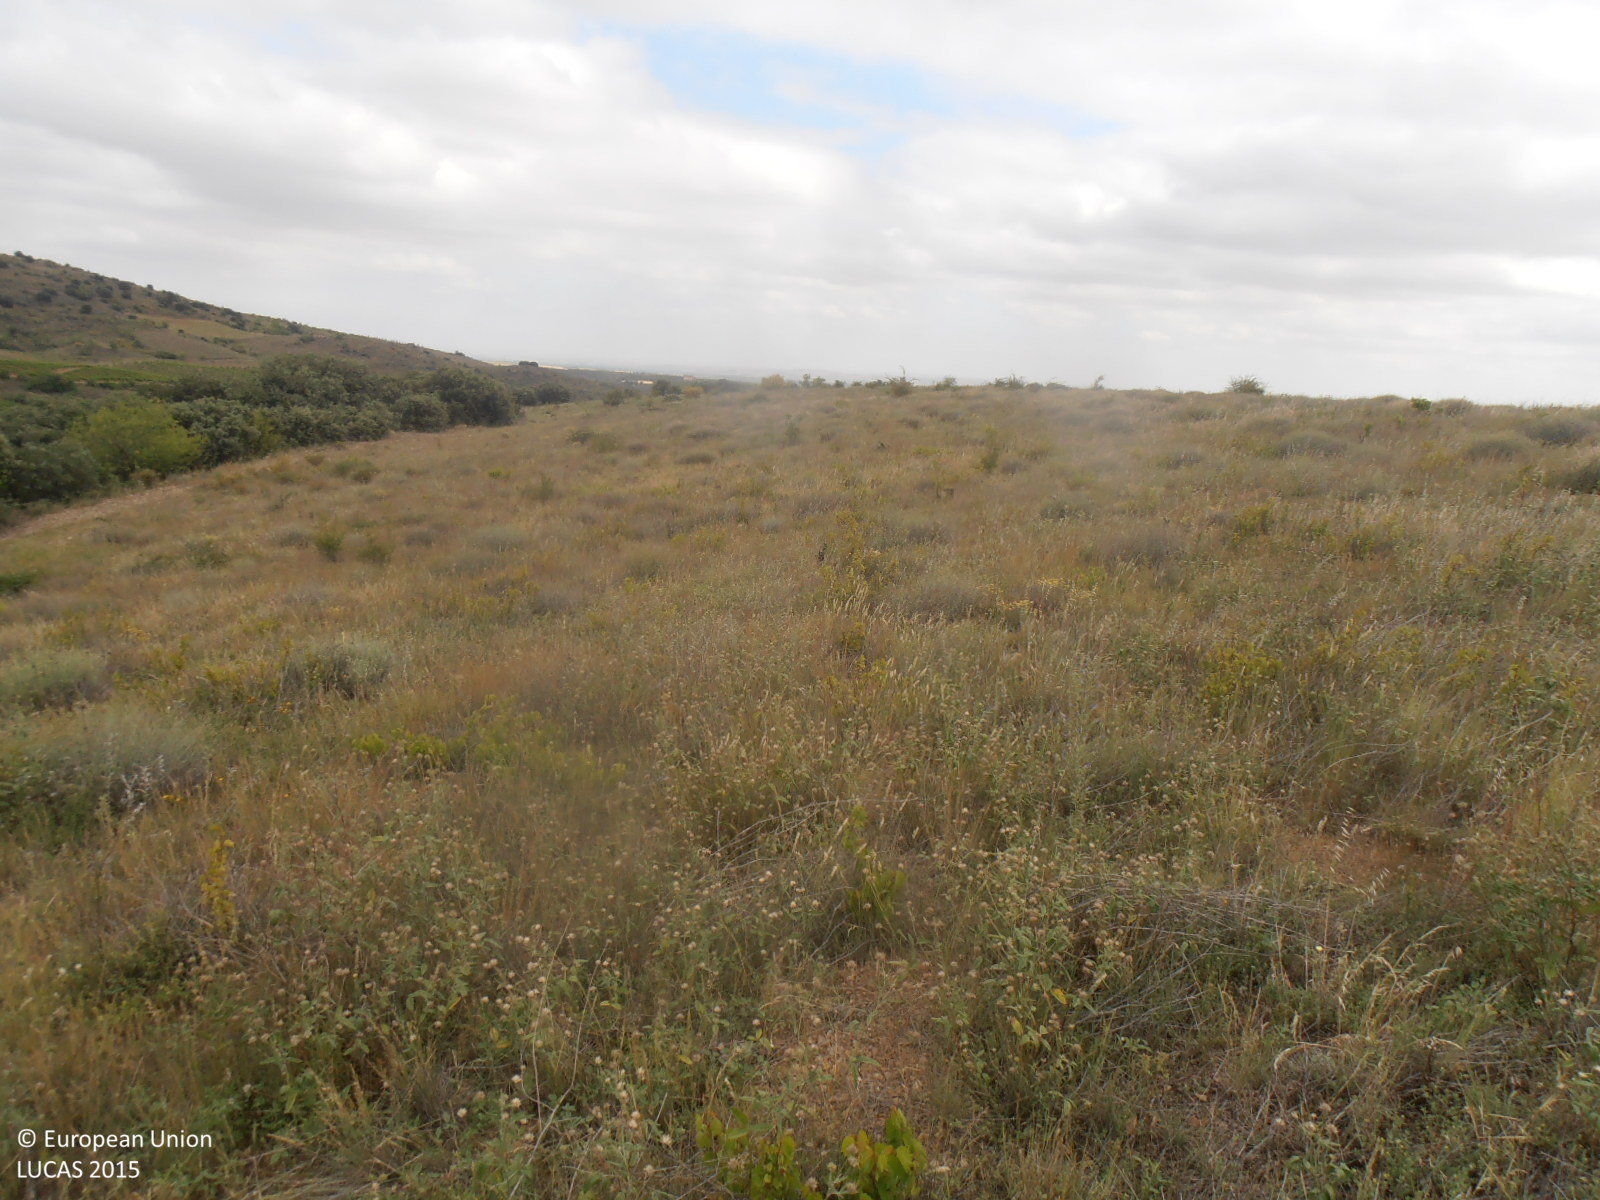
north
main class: Grassland
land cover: Spontaneously vegetated surfaces
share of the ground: > 75 %
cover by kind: herbaceous plants 95 %, shrubs 5 %
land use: Abandoned areas
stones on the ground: > 50 %
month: June
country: ES
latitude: 41.2649
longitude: -1.2051
